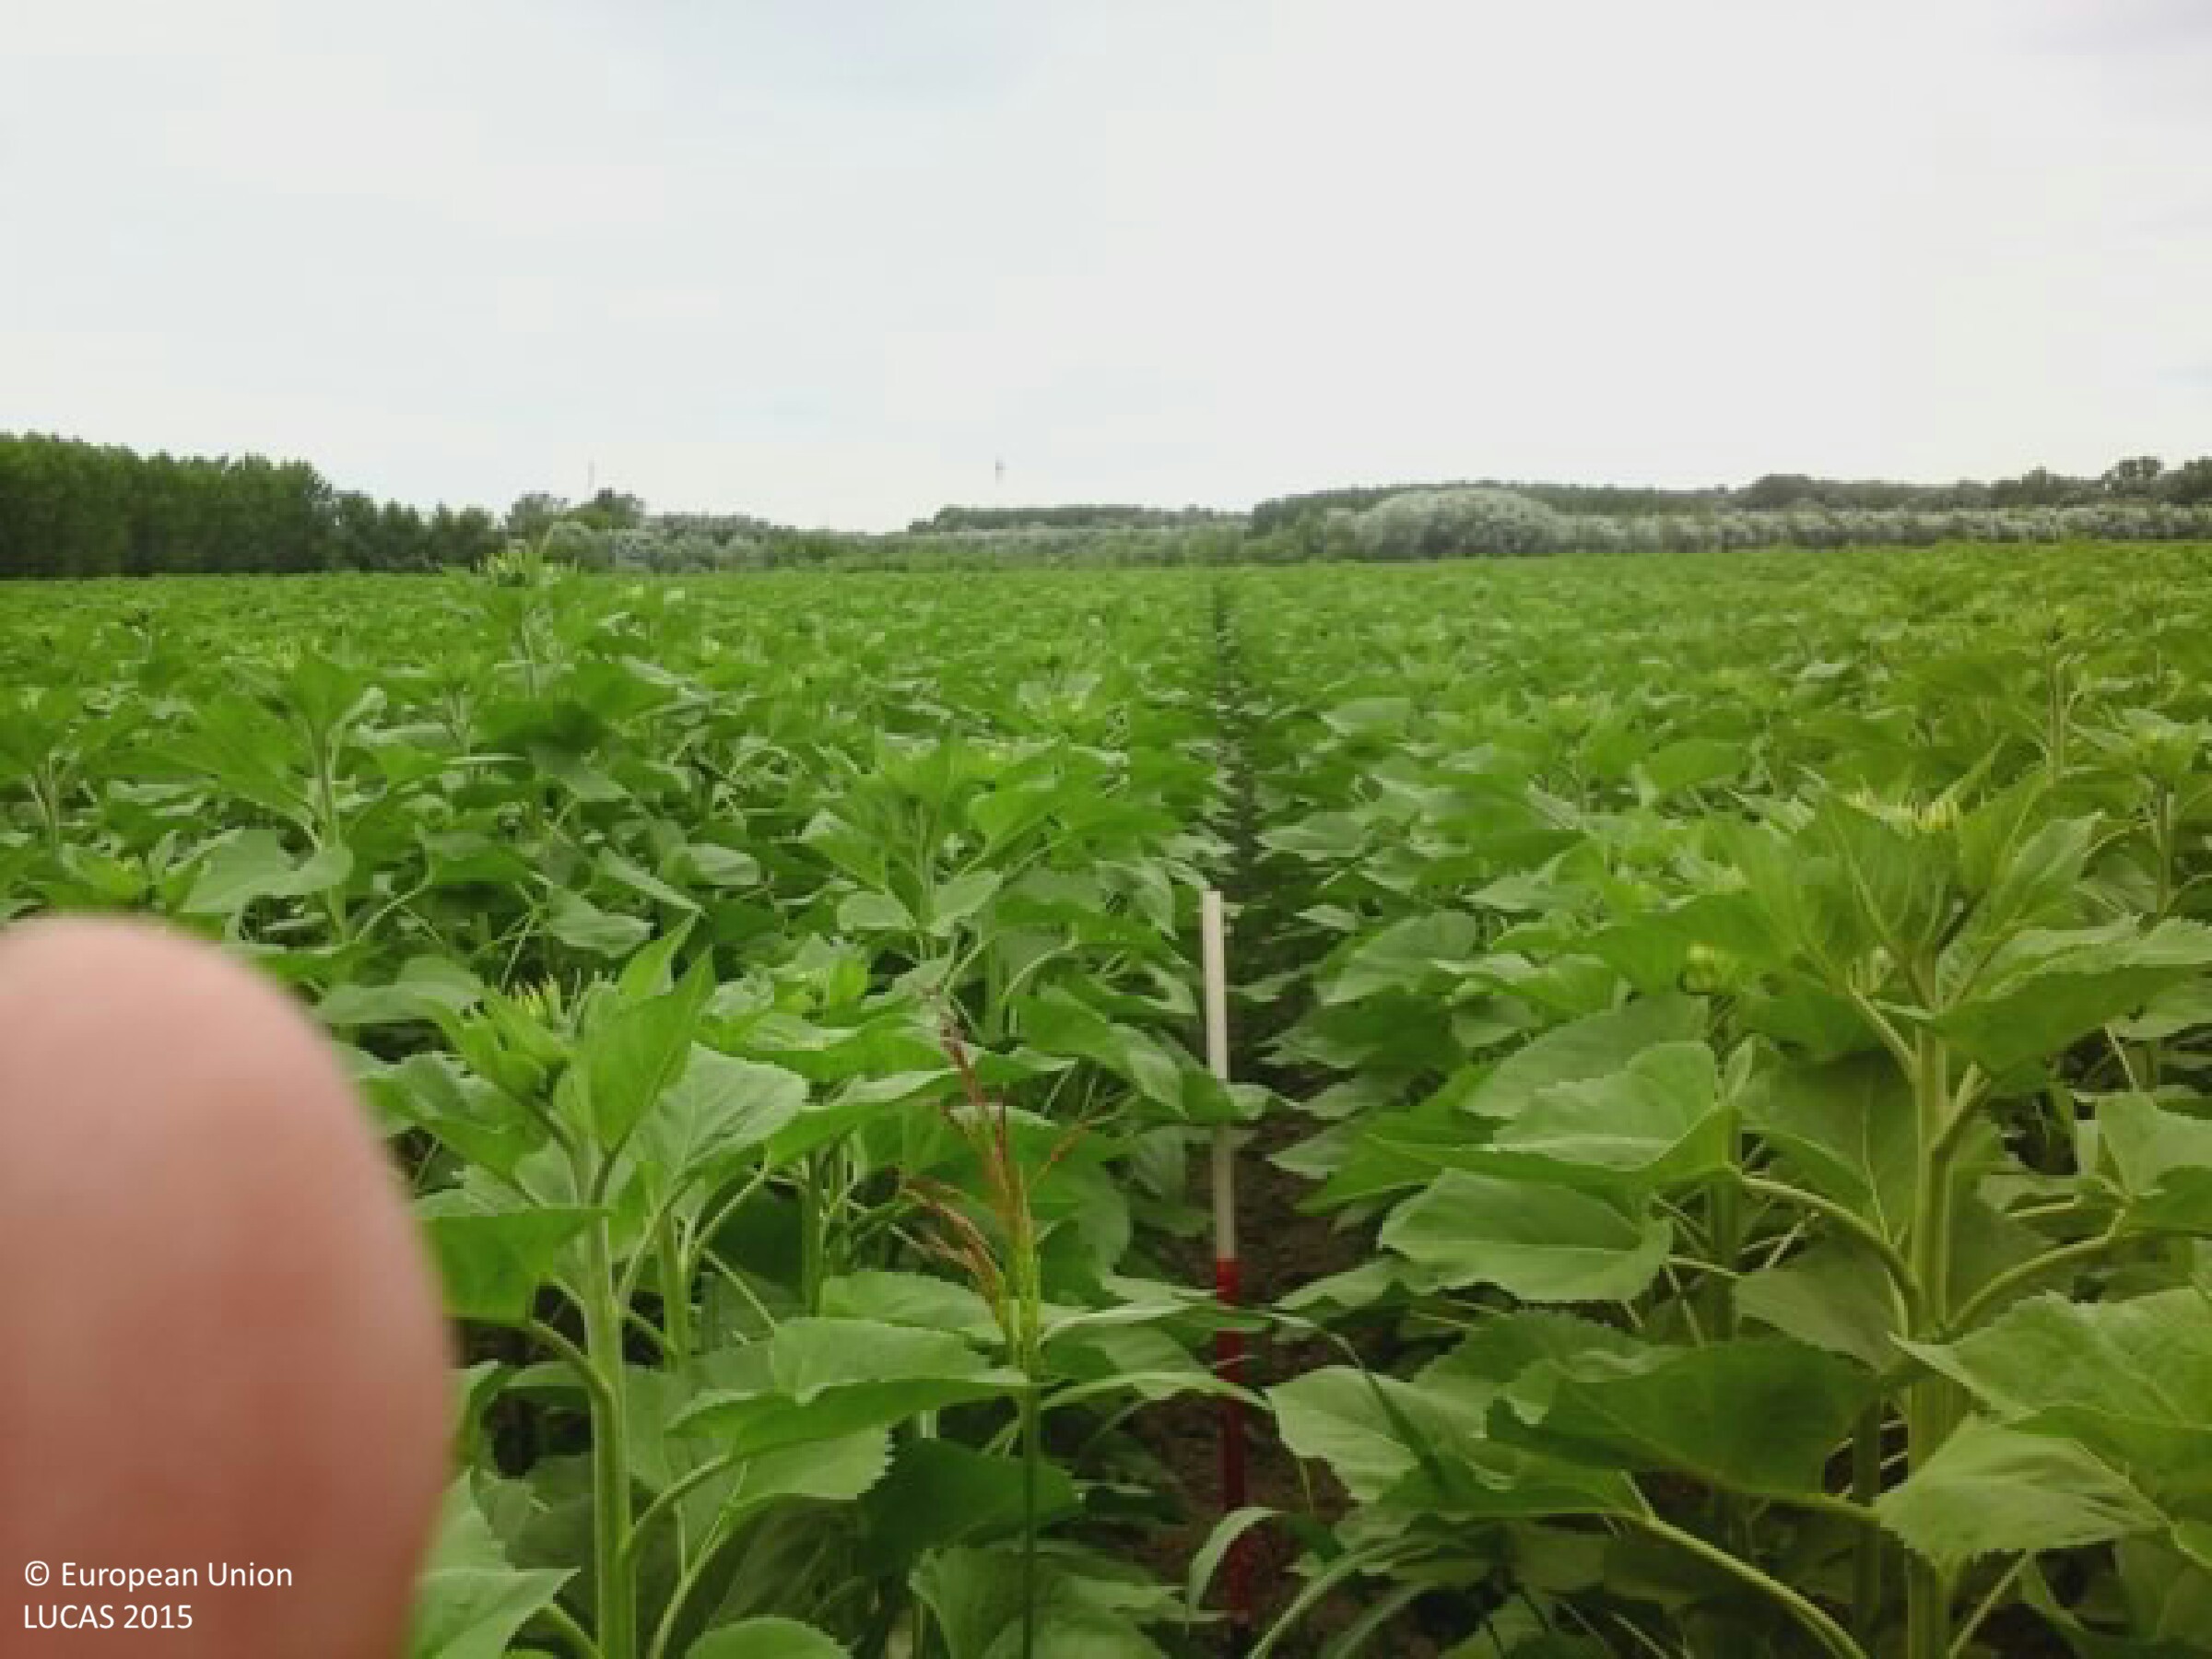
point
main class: Cropland
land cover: Sunflower
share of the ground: > 75 %
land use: Agriculture (excluding fallow land and kitchen gardens)
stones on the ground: < 10 %
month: June
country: HU
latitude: 46.1758
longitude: 18.9369
